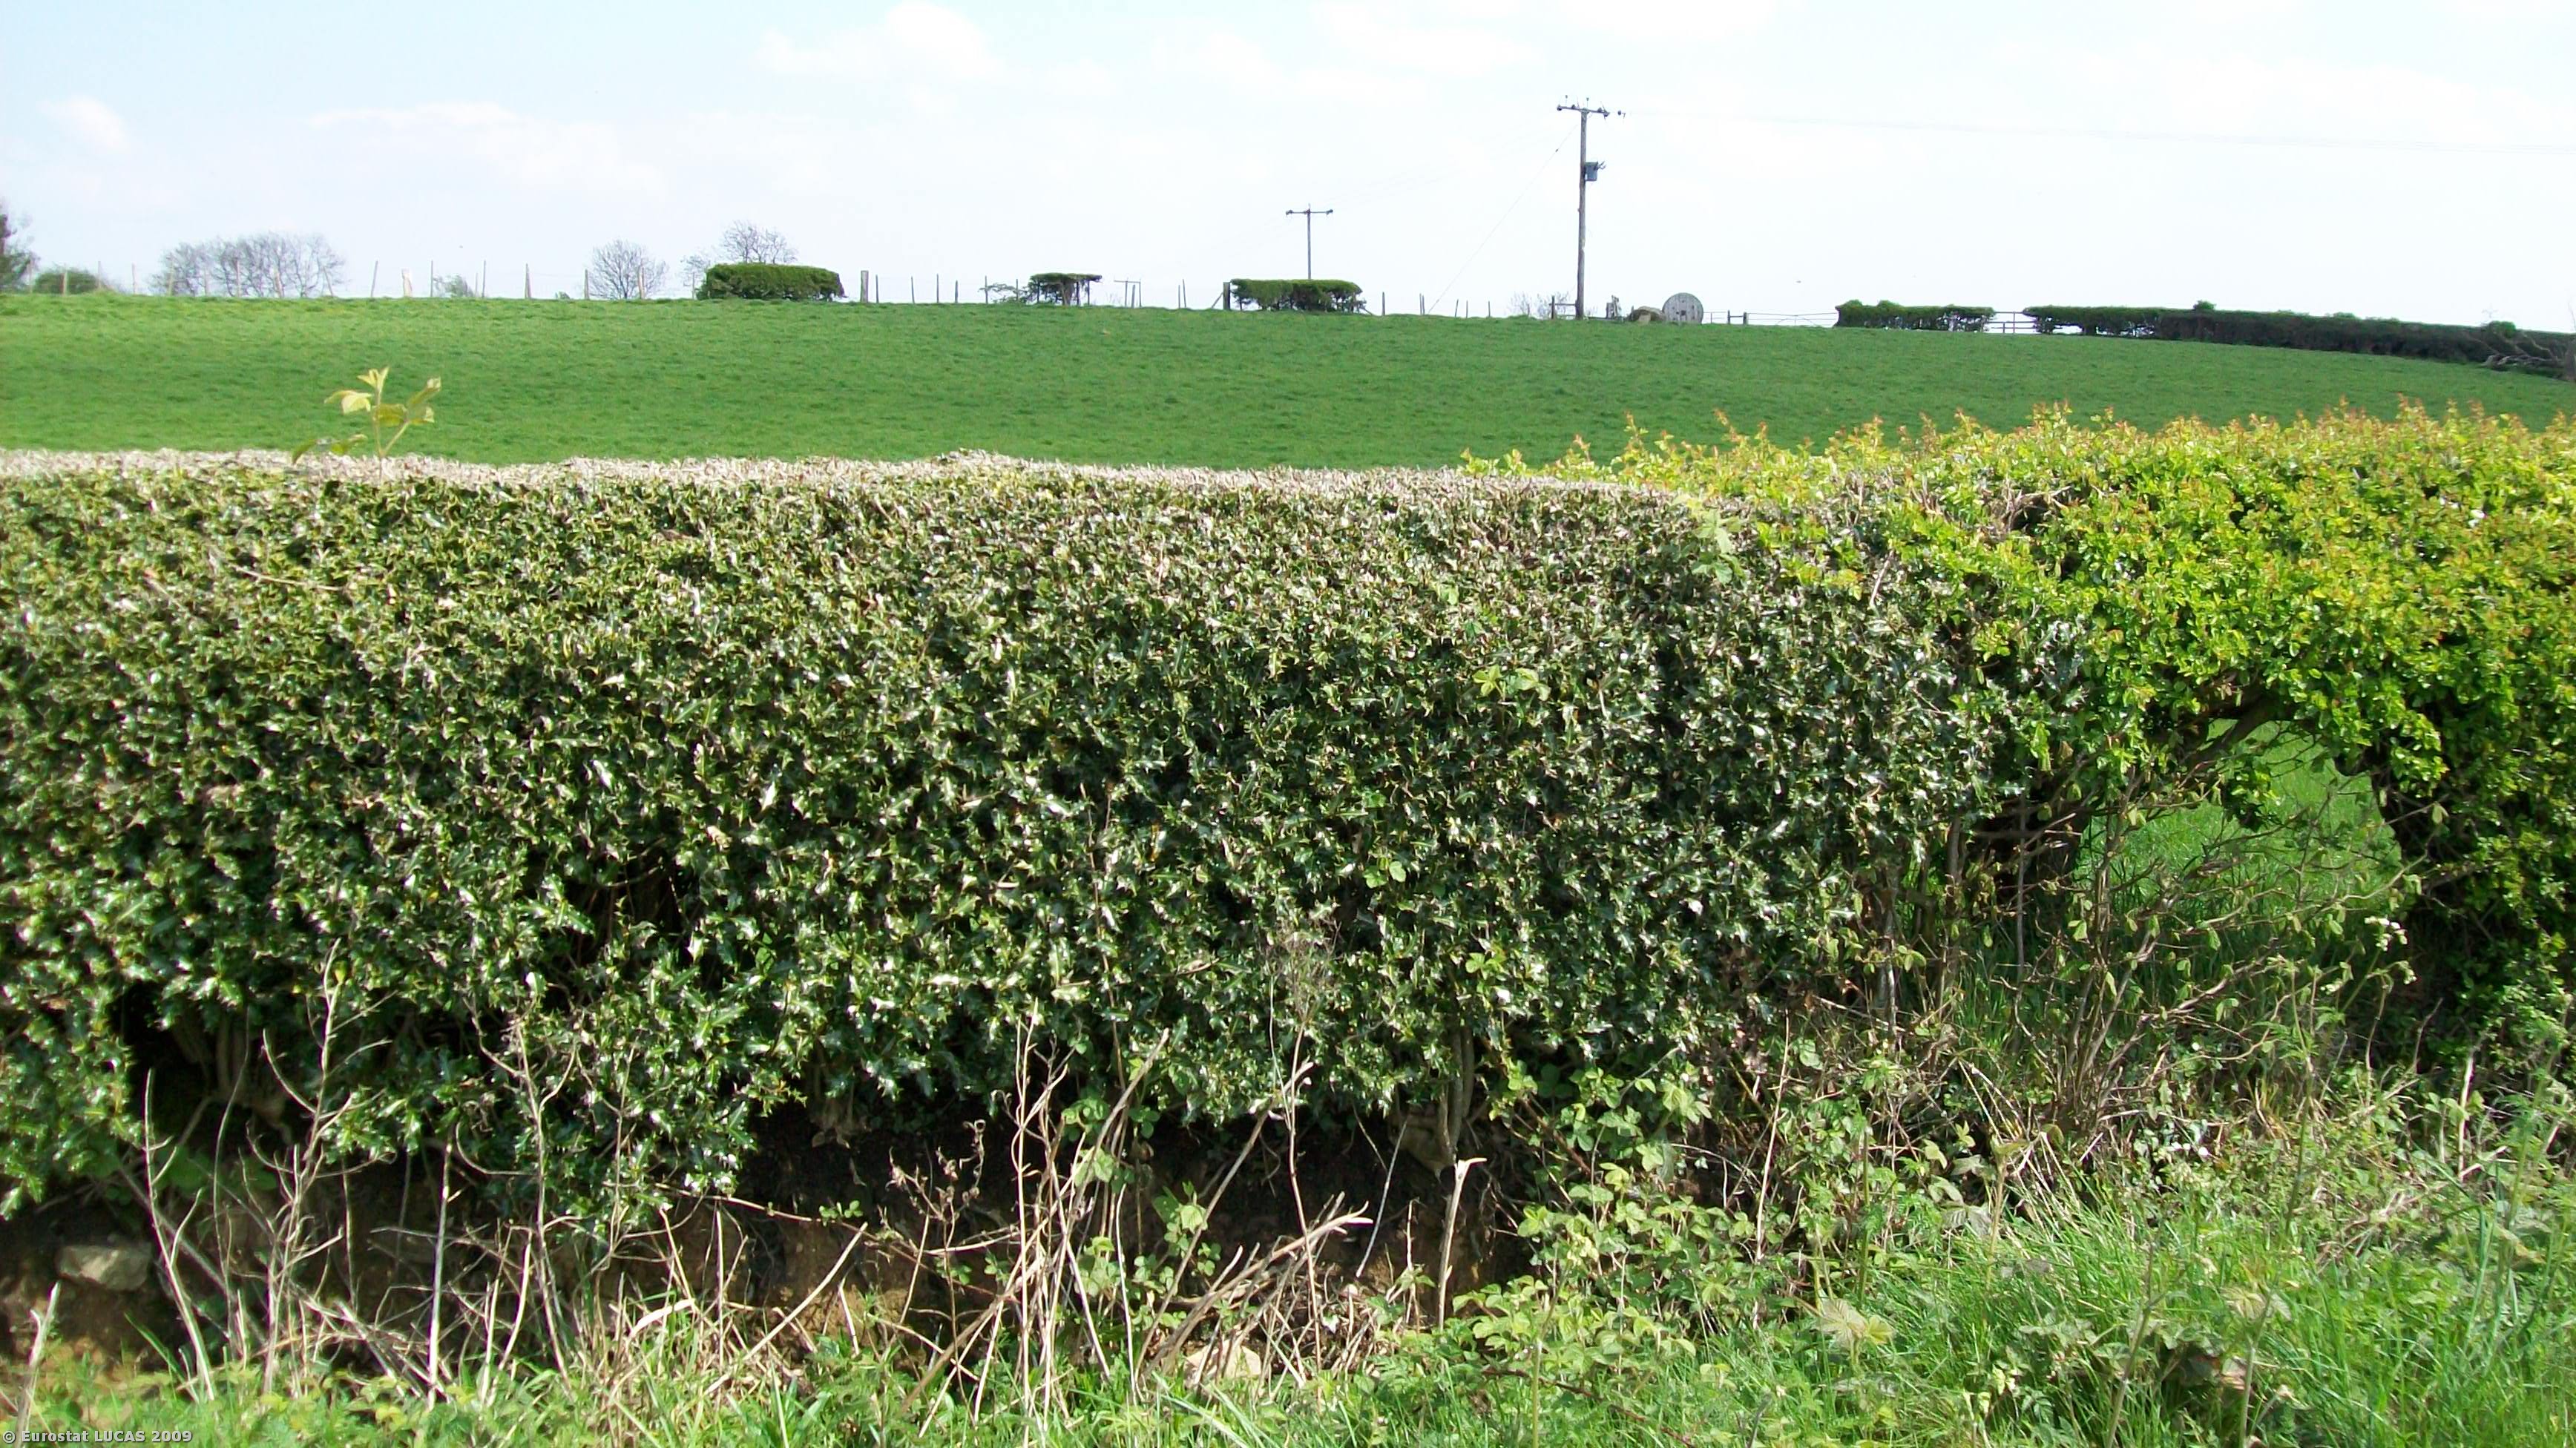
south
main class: Grassland
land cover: Grassland without tree/shrub cover
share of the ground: 25 - 50 %
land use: Agriculture (excluding fallow land and kitchen gardens)
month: April
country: GB
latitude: 53.1113
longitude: -1.4483
